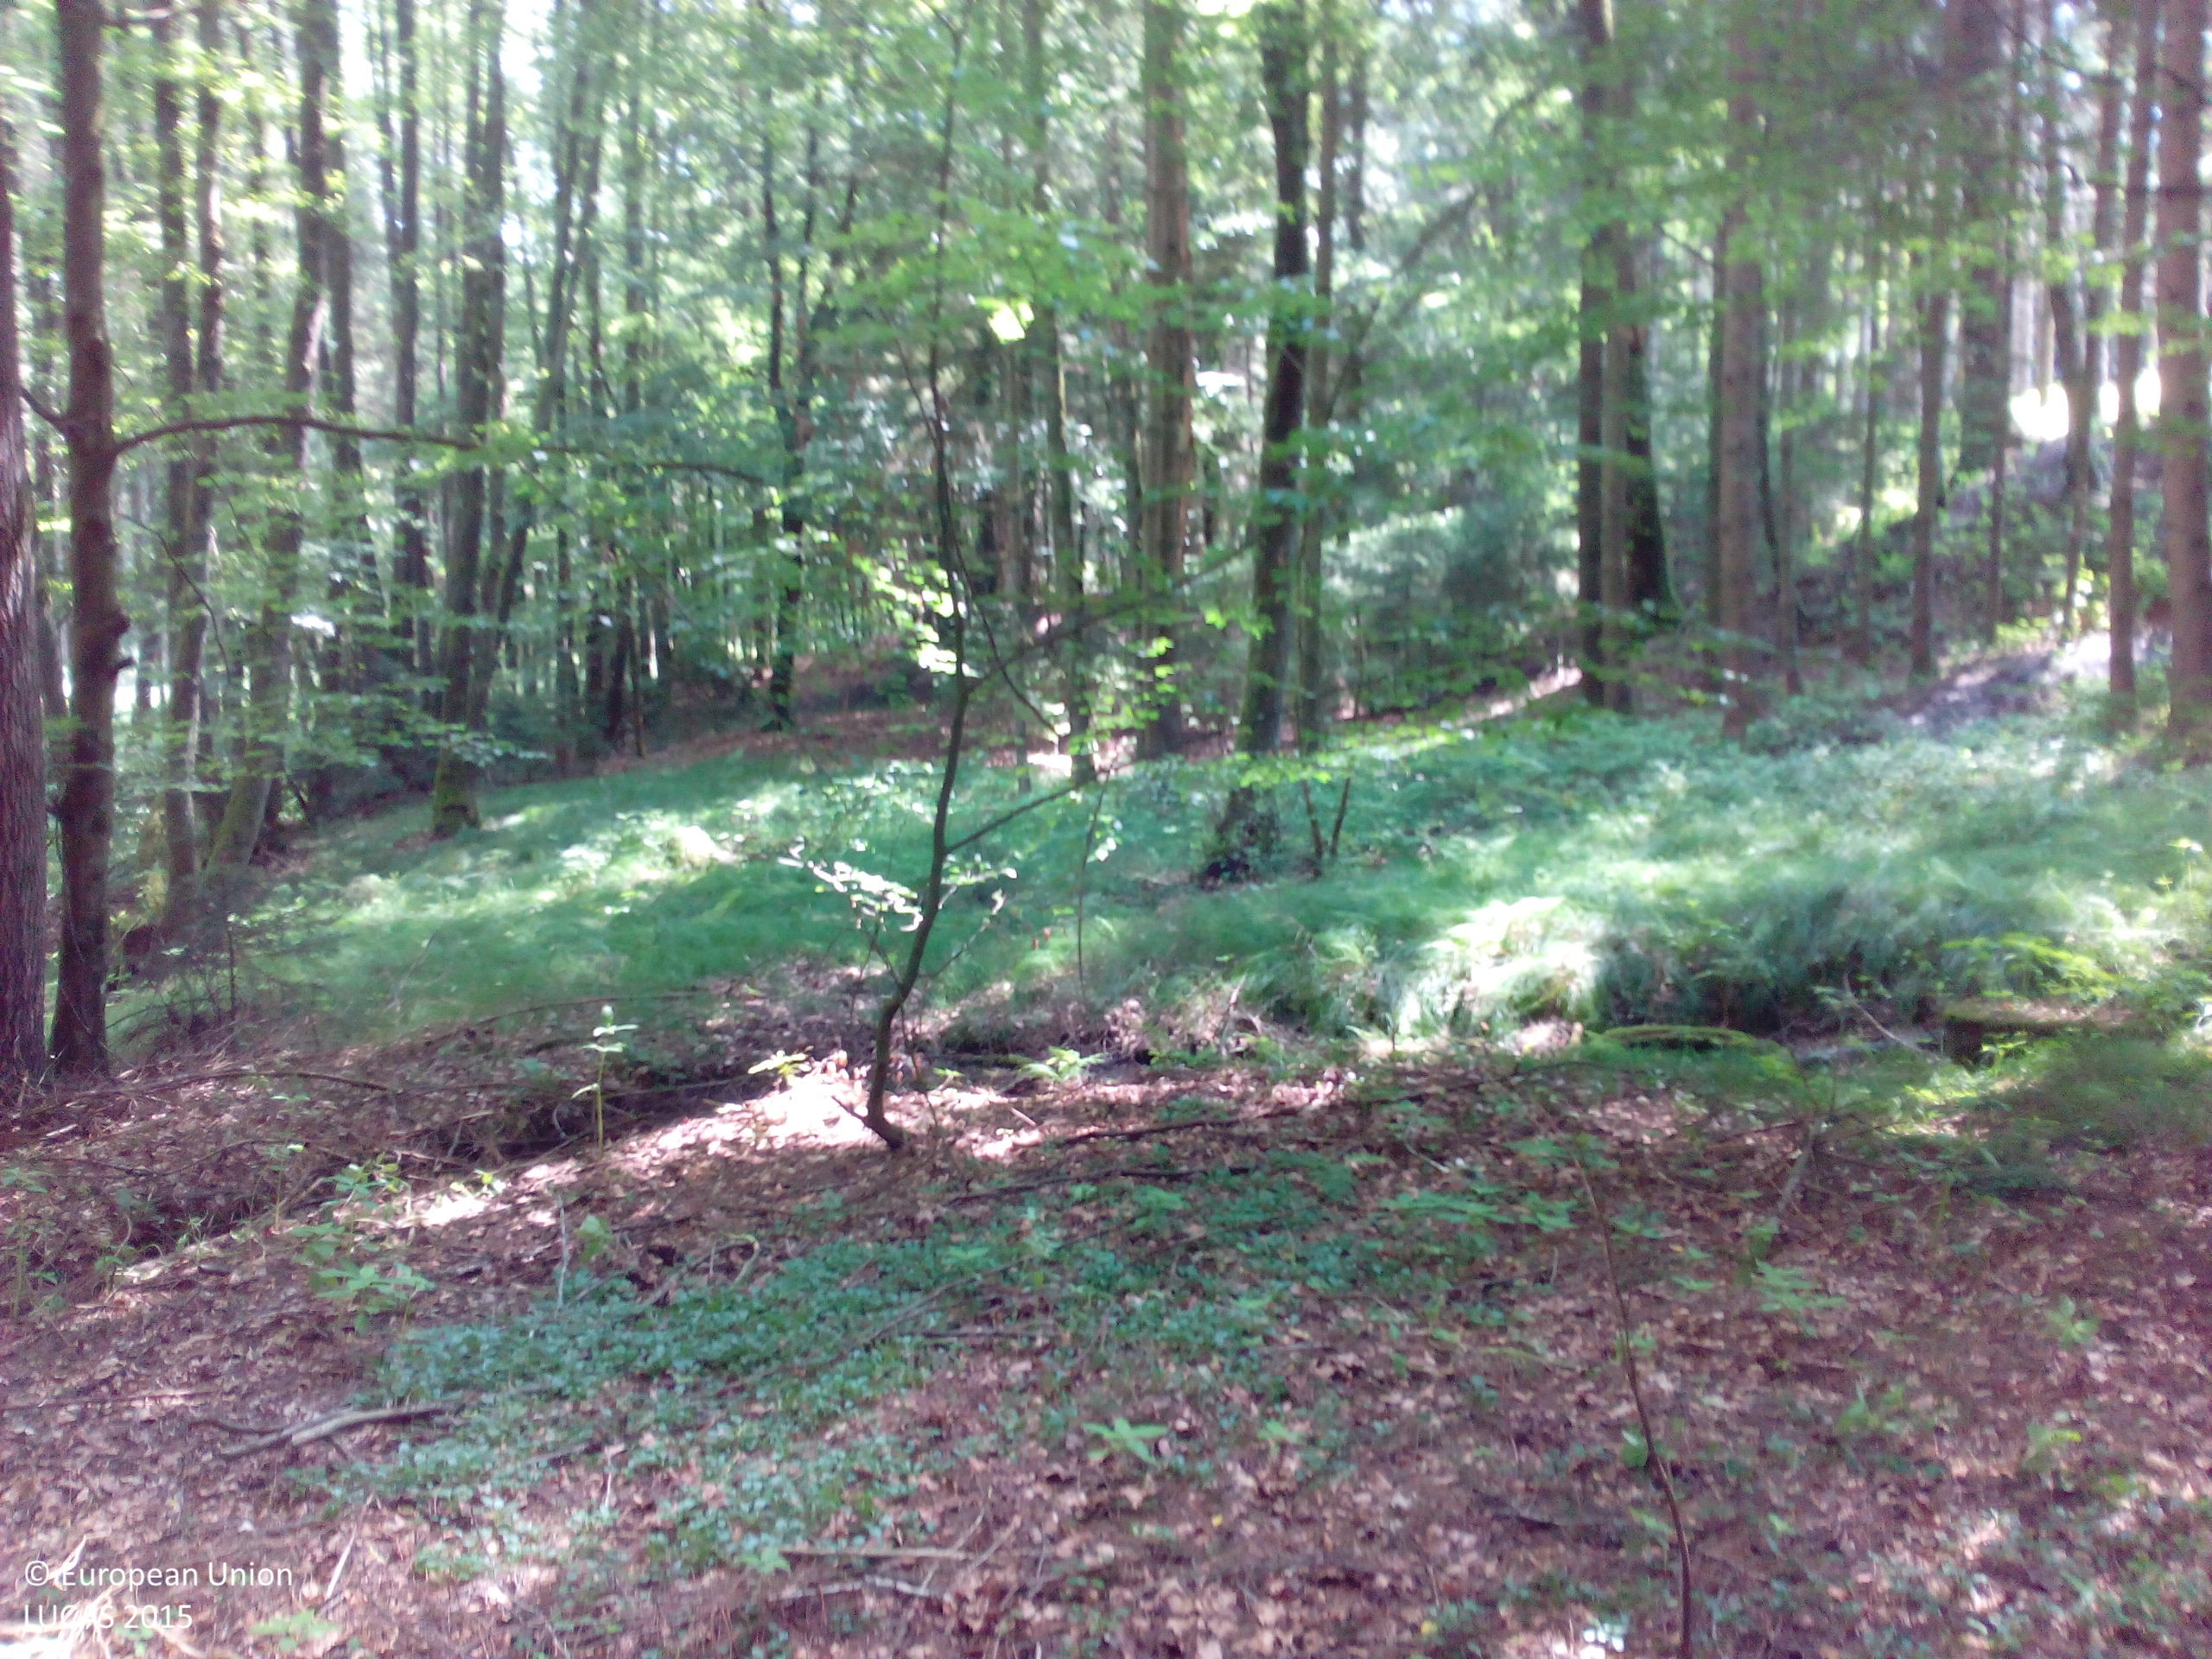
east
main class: Woodland
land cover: Spruce dominated mixed woodland
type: hemiboreal forest and nemoral coniferous forest and mixed broadleaved-coniferous forest
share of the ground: > 75 %
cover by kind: broadleaved forest trees 60 %, coniferous forest trees 25 %, unconsolidated bare surface 10 %, herbaceous plants 5 %
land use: Forestry
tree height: > 5 m
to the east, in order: Spruce dominated mixed woodland; Broadleaved woodland; Spruce dominated coniferous woodland; Rivers and streams; Broadleaved woodland
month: June
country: DE
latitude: 48.5086
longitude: 12.9366
